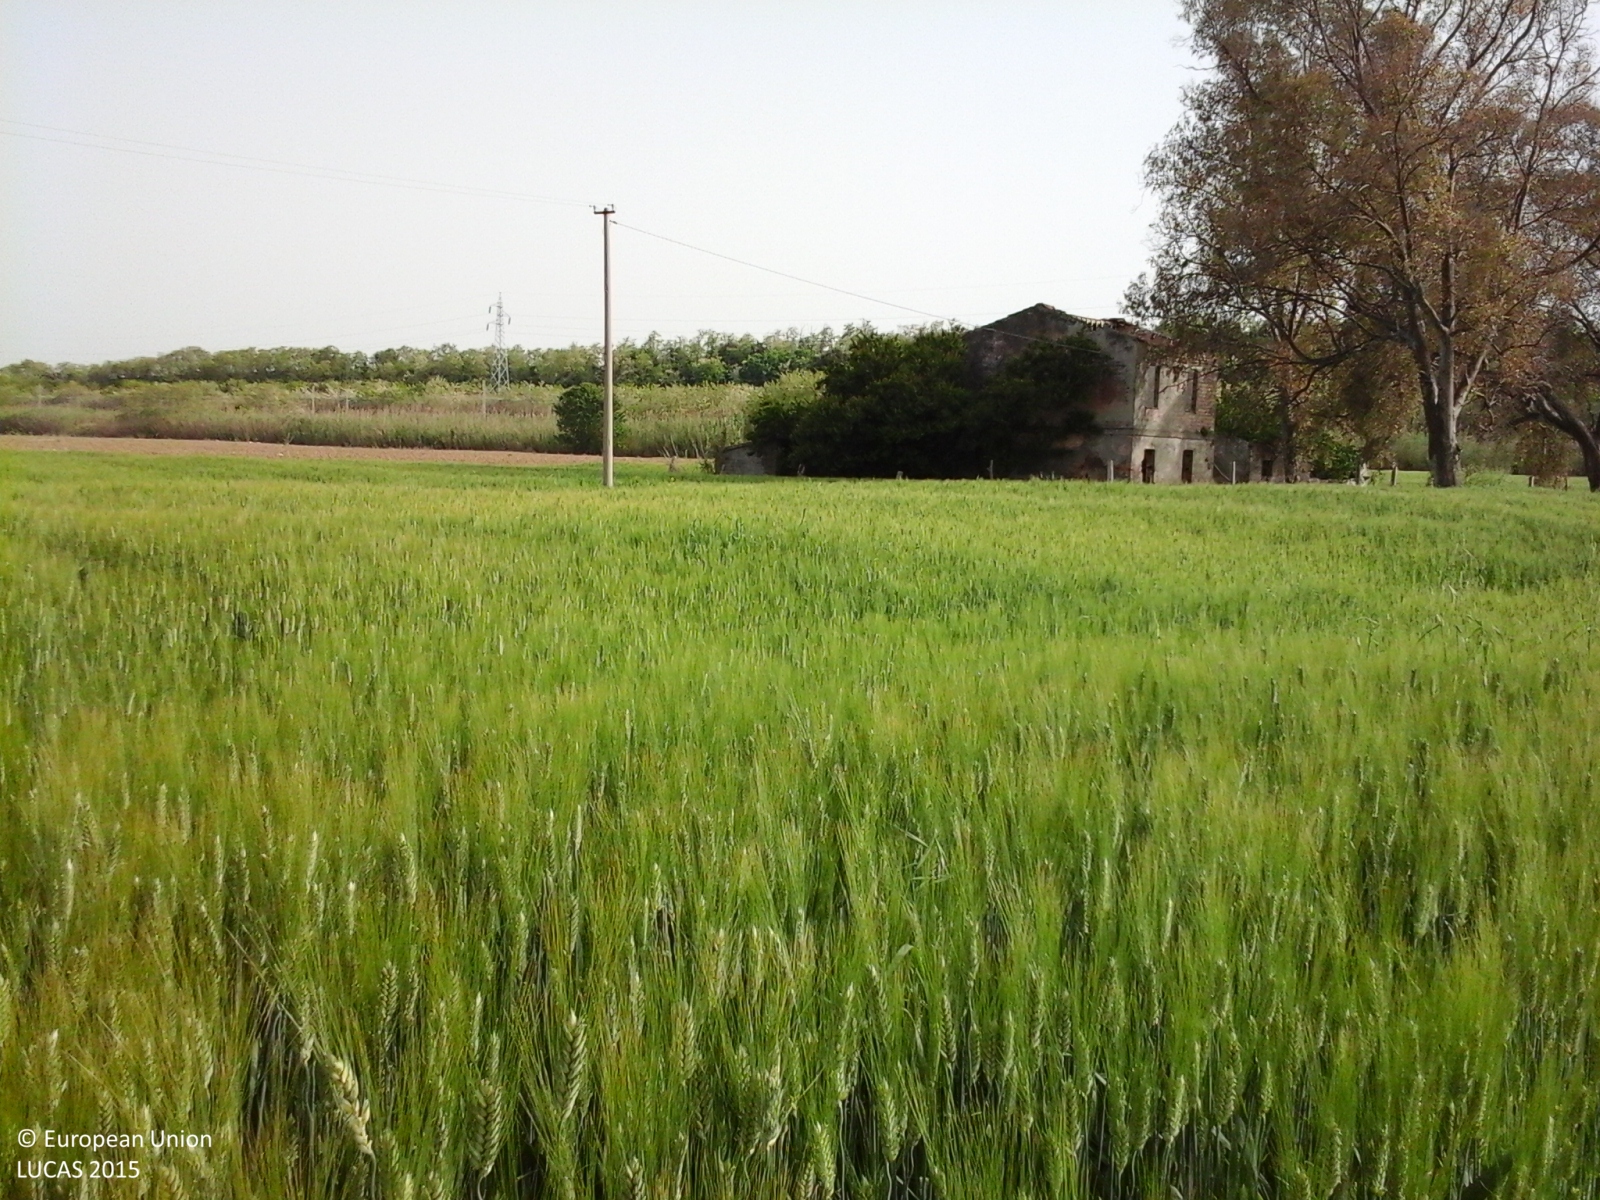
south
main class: Cropland
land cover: Durum wheat
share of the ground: > 75 %
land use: Agriculture (excluding fallow land and kitchen gardens)
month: May
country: IT
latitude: 42.0717
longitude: 14.7596
